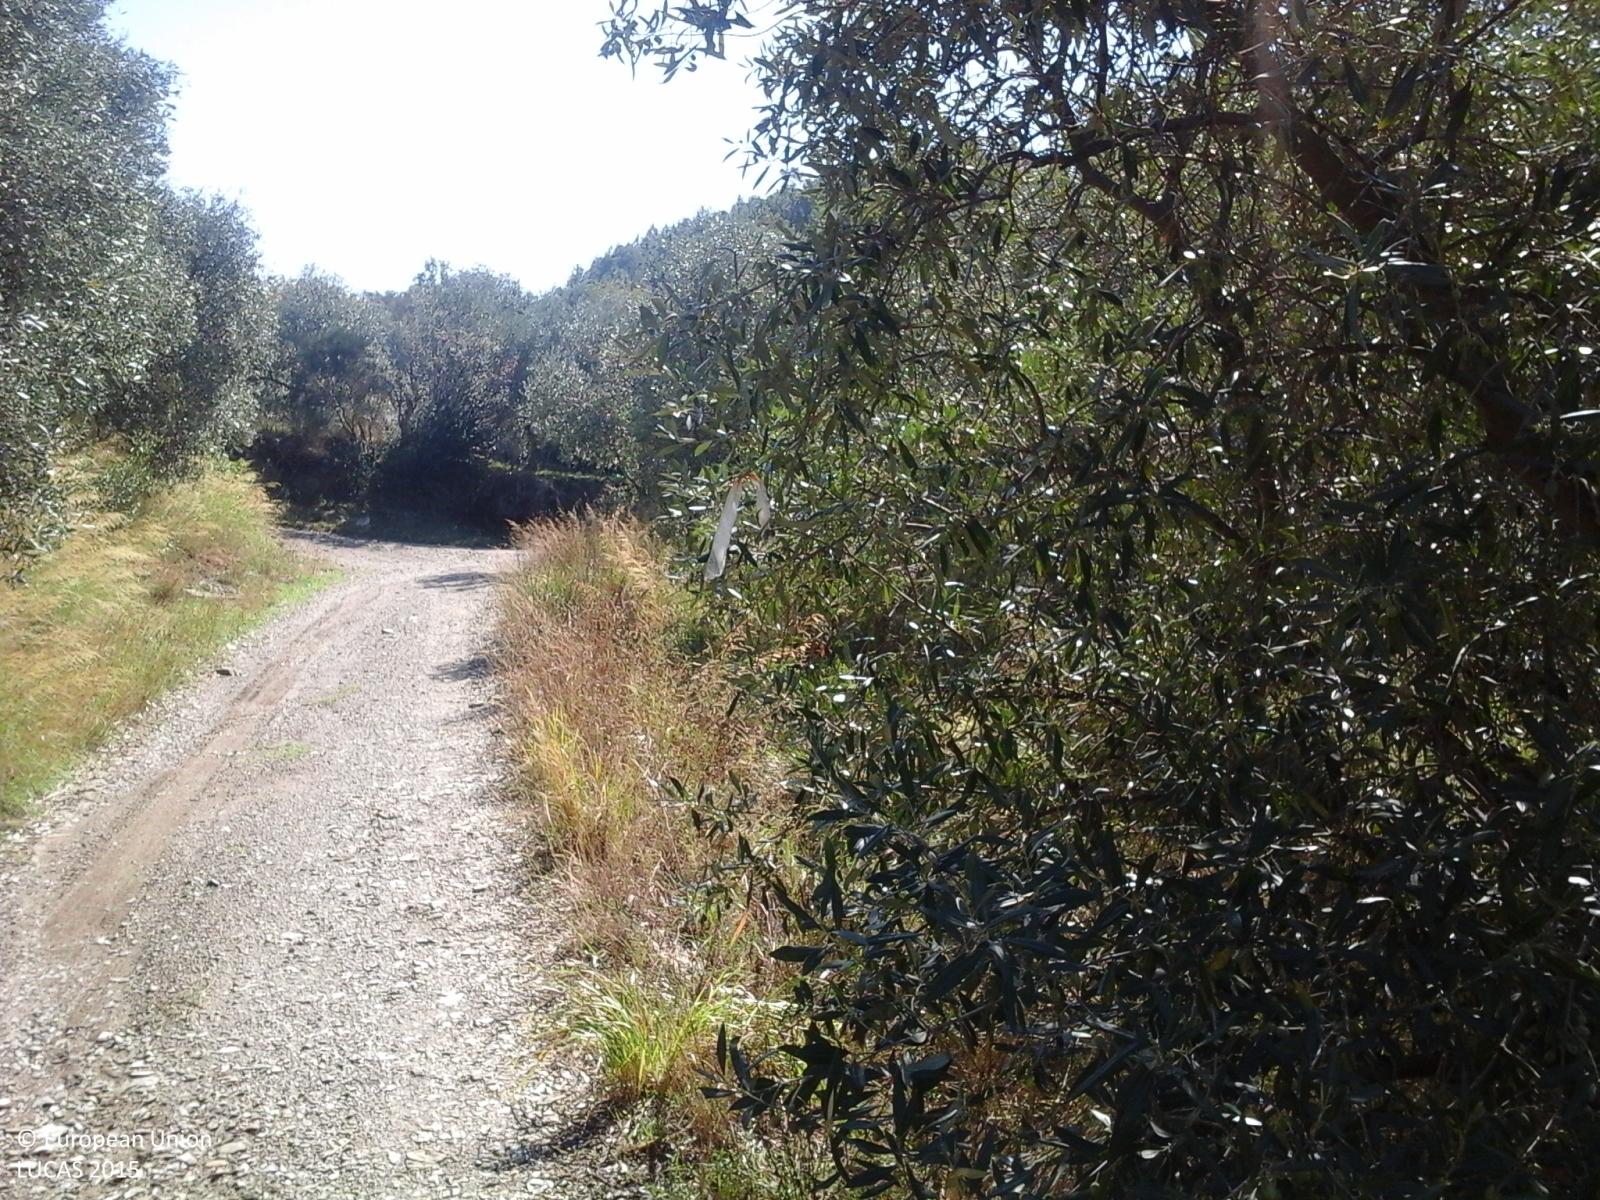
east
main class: Cropland
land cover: Olive groves
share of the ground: 50 - 75 %
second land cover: Grassland without tree/shrub cover
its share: 25 - 50 %
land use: Agriculture (excluding fallow land and kitchen gardens)
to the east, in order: Tracks; Olive groves; Tracks; Shrubland with sparse tree cover; Olive groves; Broadleaved woodland
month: October
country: IT
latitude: 44.0814
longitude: 8.1437
